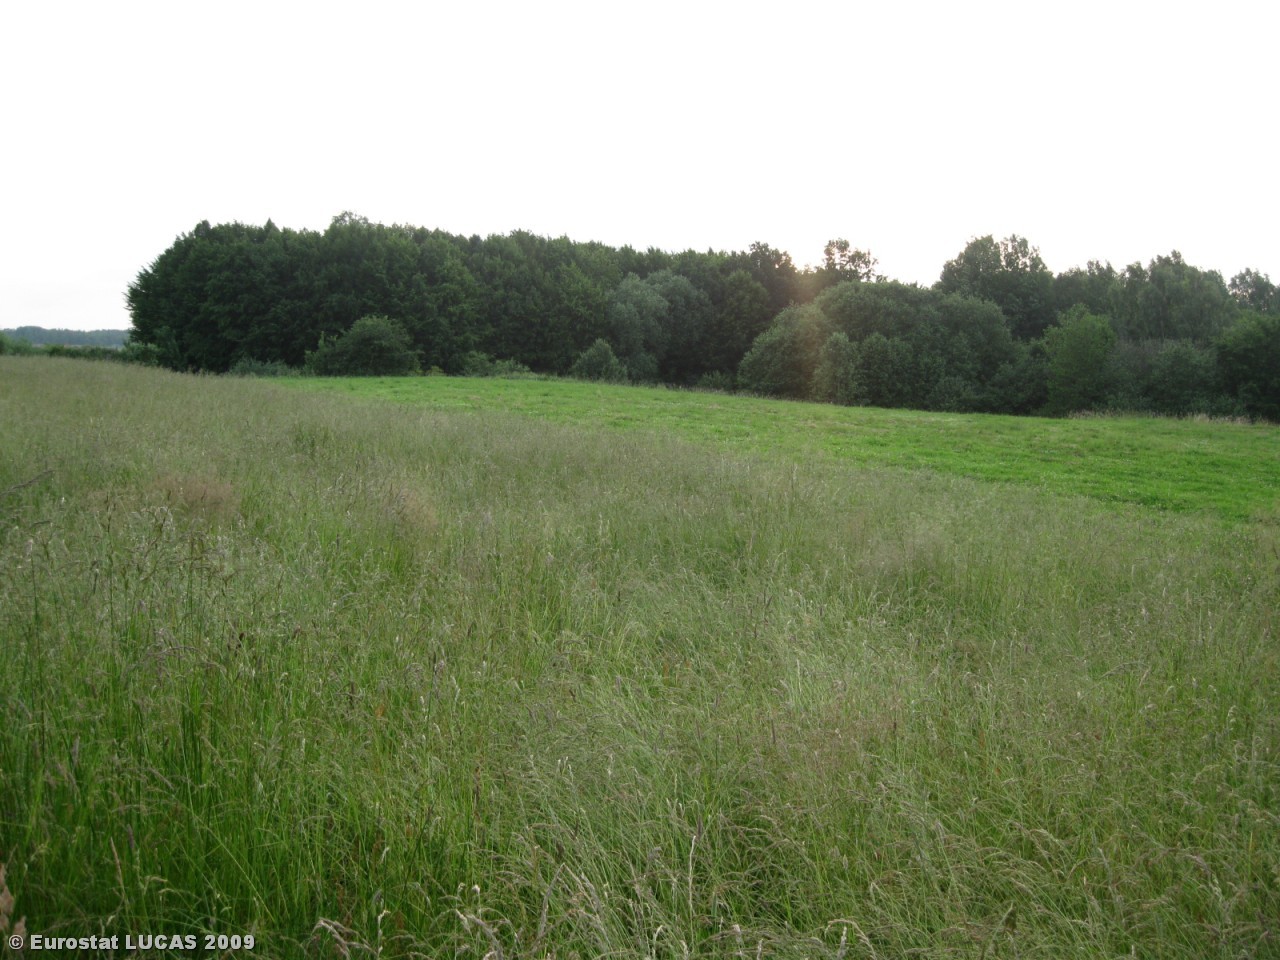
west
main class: Grassland
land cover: Grassland without tree/shrub cover
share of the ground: > 75 %
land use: Agriculture (excluding fallow land and kitchen gardens)
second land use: Amenities, museums, leisure
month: June
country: LT
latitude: 55.0500
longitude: 22.6336
